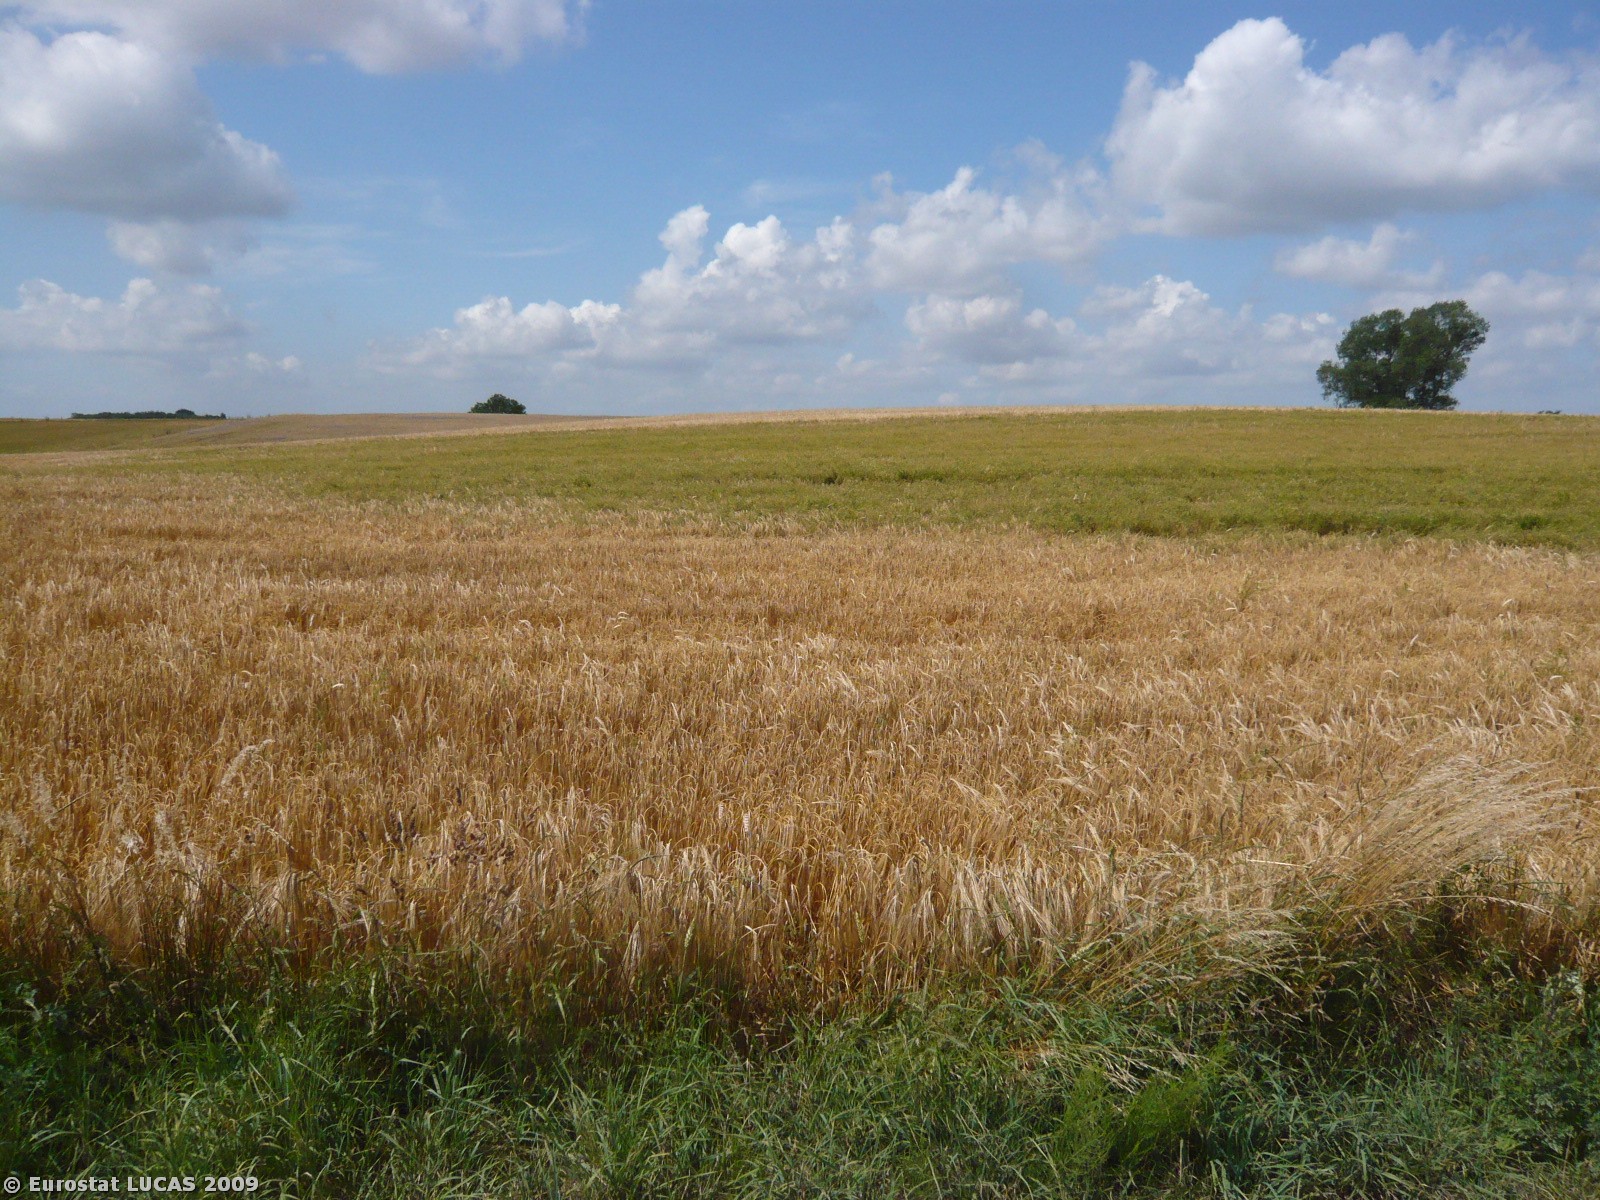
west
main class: Cropland
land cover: Barley
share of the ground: > 75 %
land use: Agriculture (excluding fallow land and kitchen gardens)
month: July
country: DK
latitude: 55.6902
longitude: 11.7641
